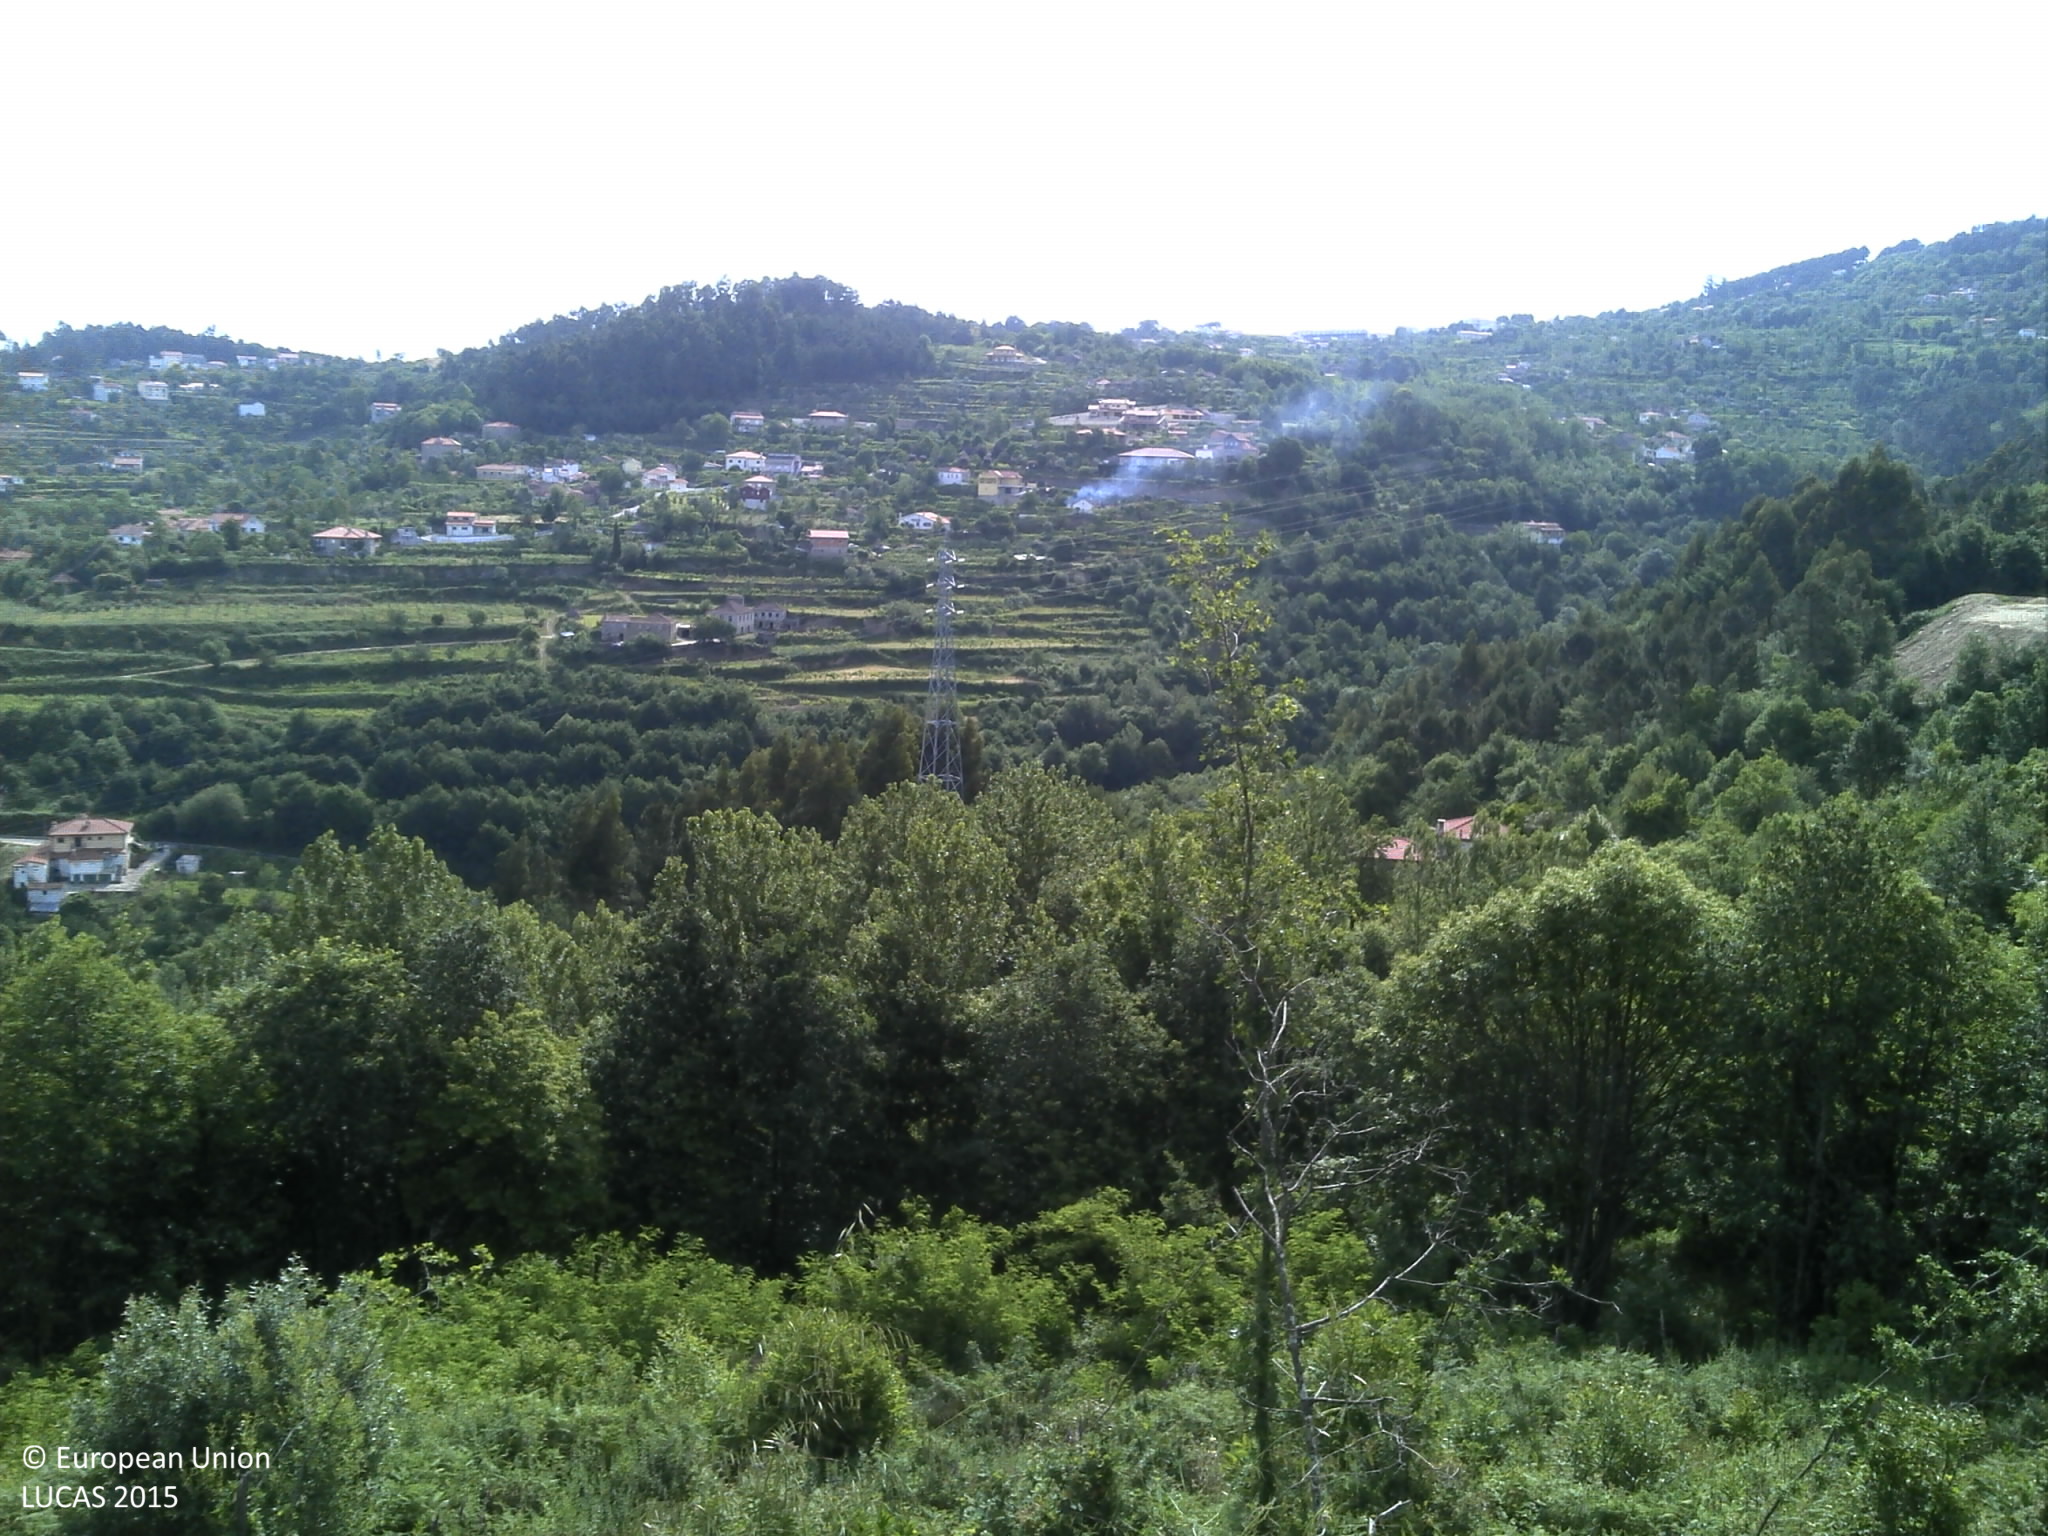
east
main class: Woodland
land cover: Broadleaved woodland
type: thermophilous deciduous forest
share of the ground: > 75 %
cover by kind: broadleaved forest trees 85 %, shrubs 5 %, herbaceous plants 5 %, unconsolidated bare surface 5 %
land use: Forestry
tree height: > 5 m
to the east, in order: Broadleaved woodland; Dry stone walls; Arable land (only in case pi); Dry stone walls; Tracks; Fences; Broadleaved woodland; Electric lines; Broadleaved woodland
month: May
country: PT
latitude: 41.0770
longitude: -8.1217
